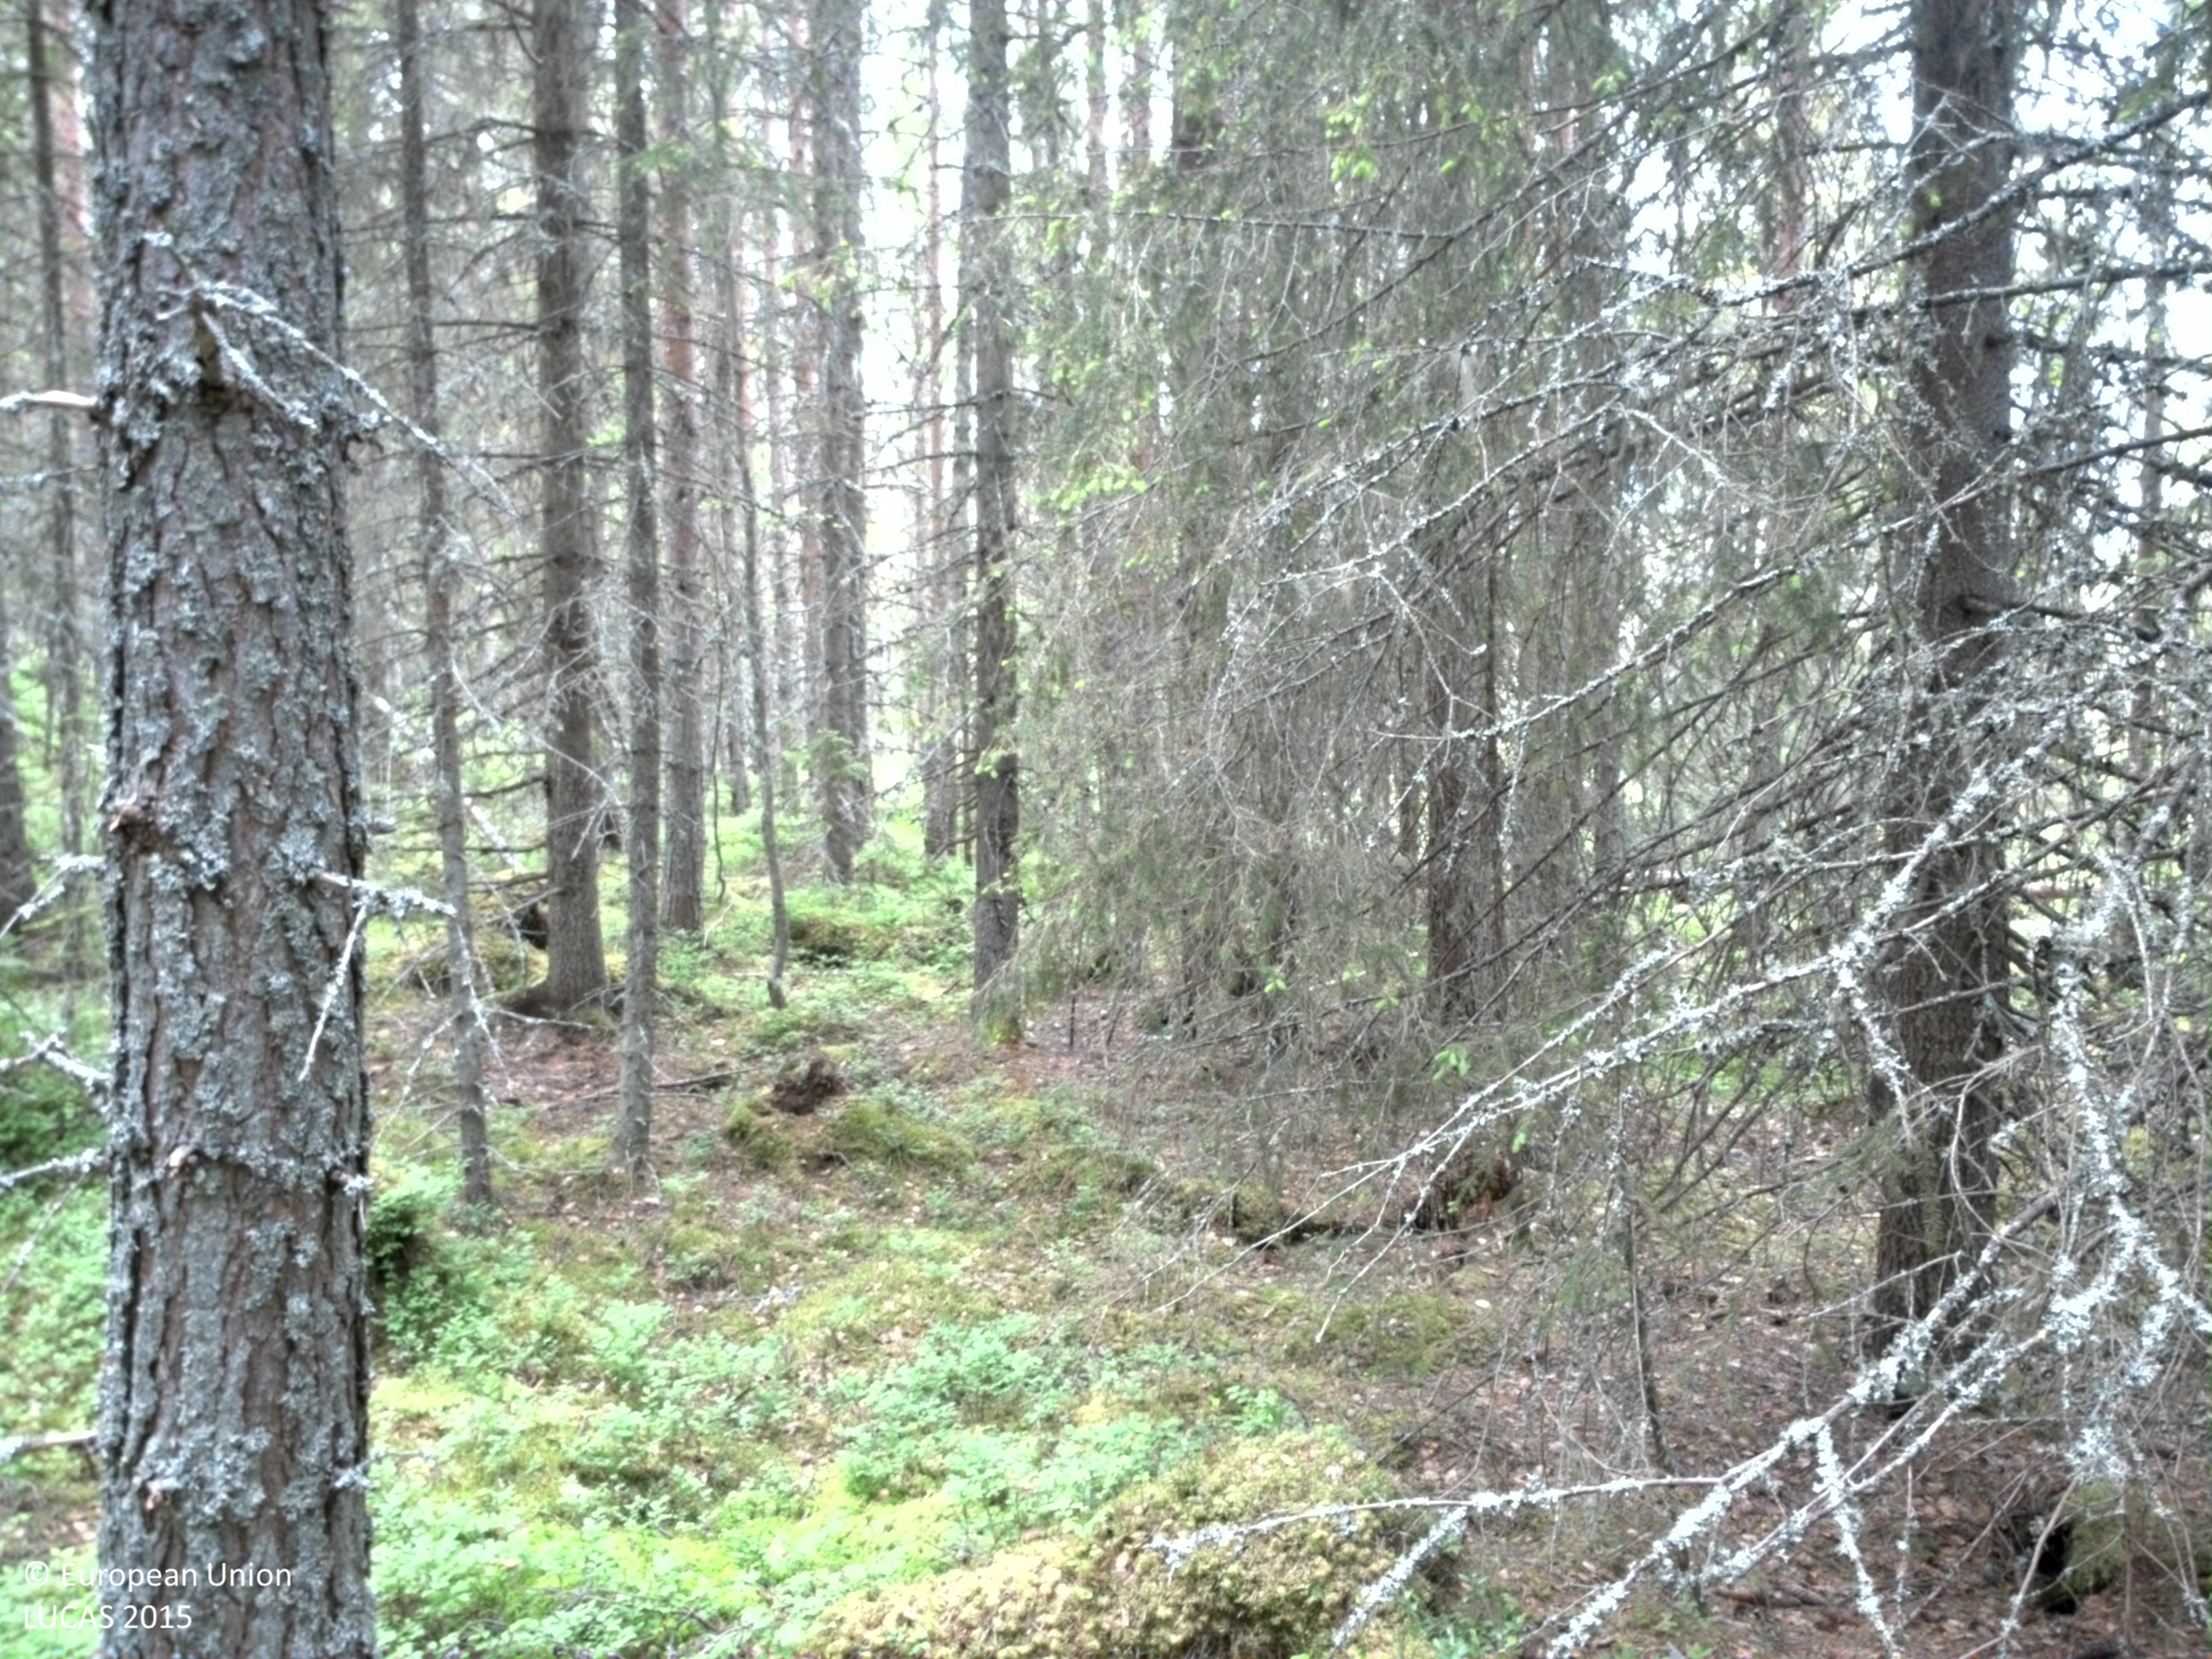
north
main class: Woodland
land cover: Spruce dominated coniferous woodland
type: boreal forest
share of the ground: > 75 %
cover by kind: coniferous forest trees 75 %, broadleaved forest trees 15 %, lichens and mosses 10 %
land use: Forestry
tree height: > 5 m
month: June
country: SE
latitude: 61.1278
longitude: 13.5341
